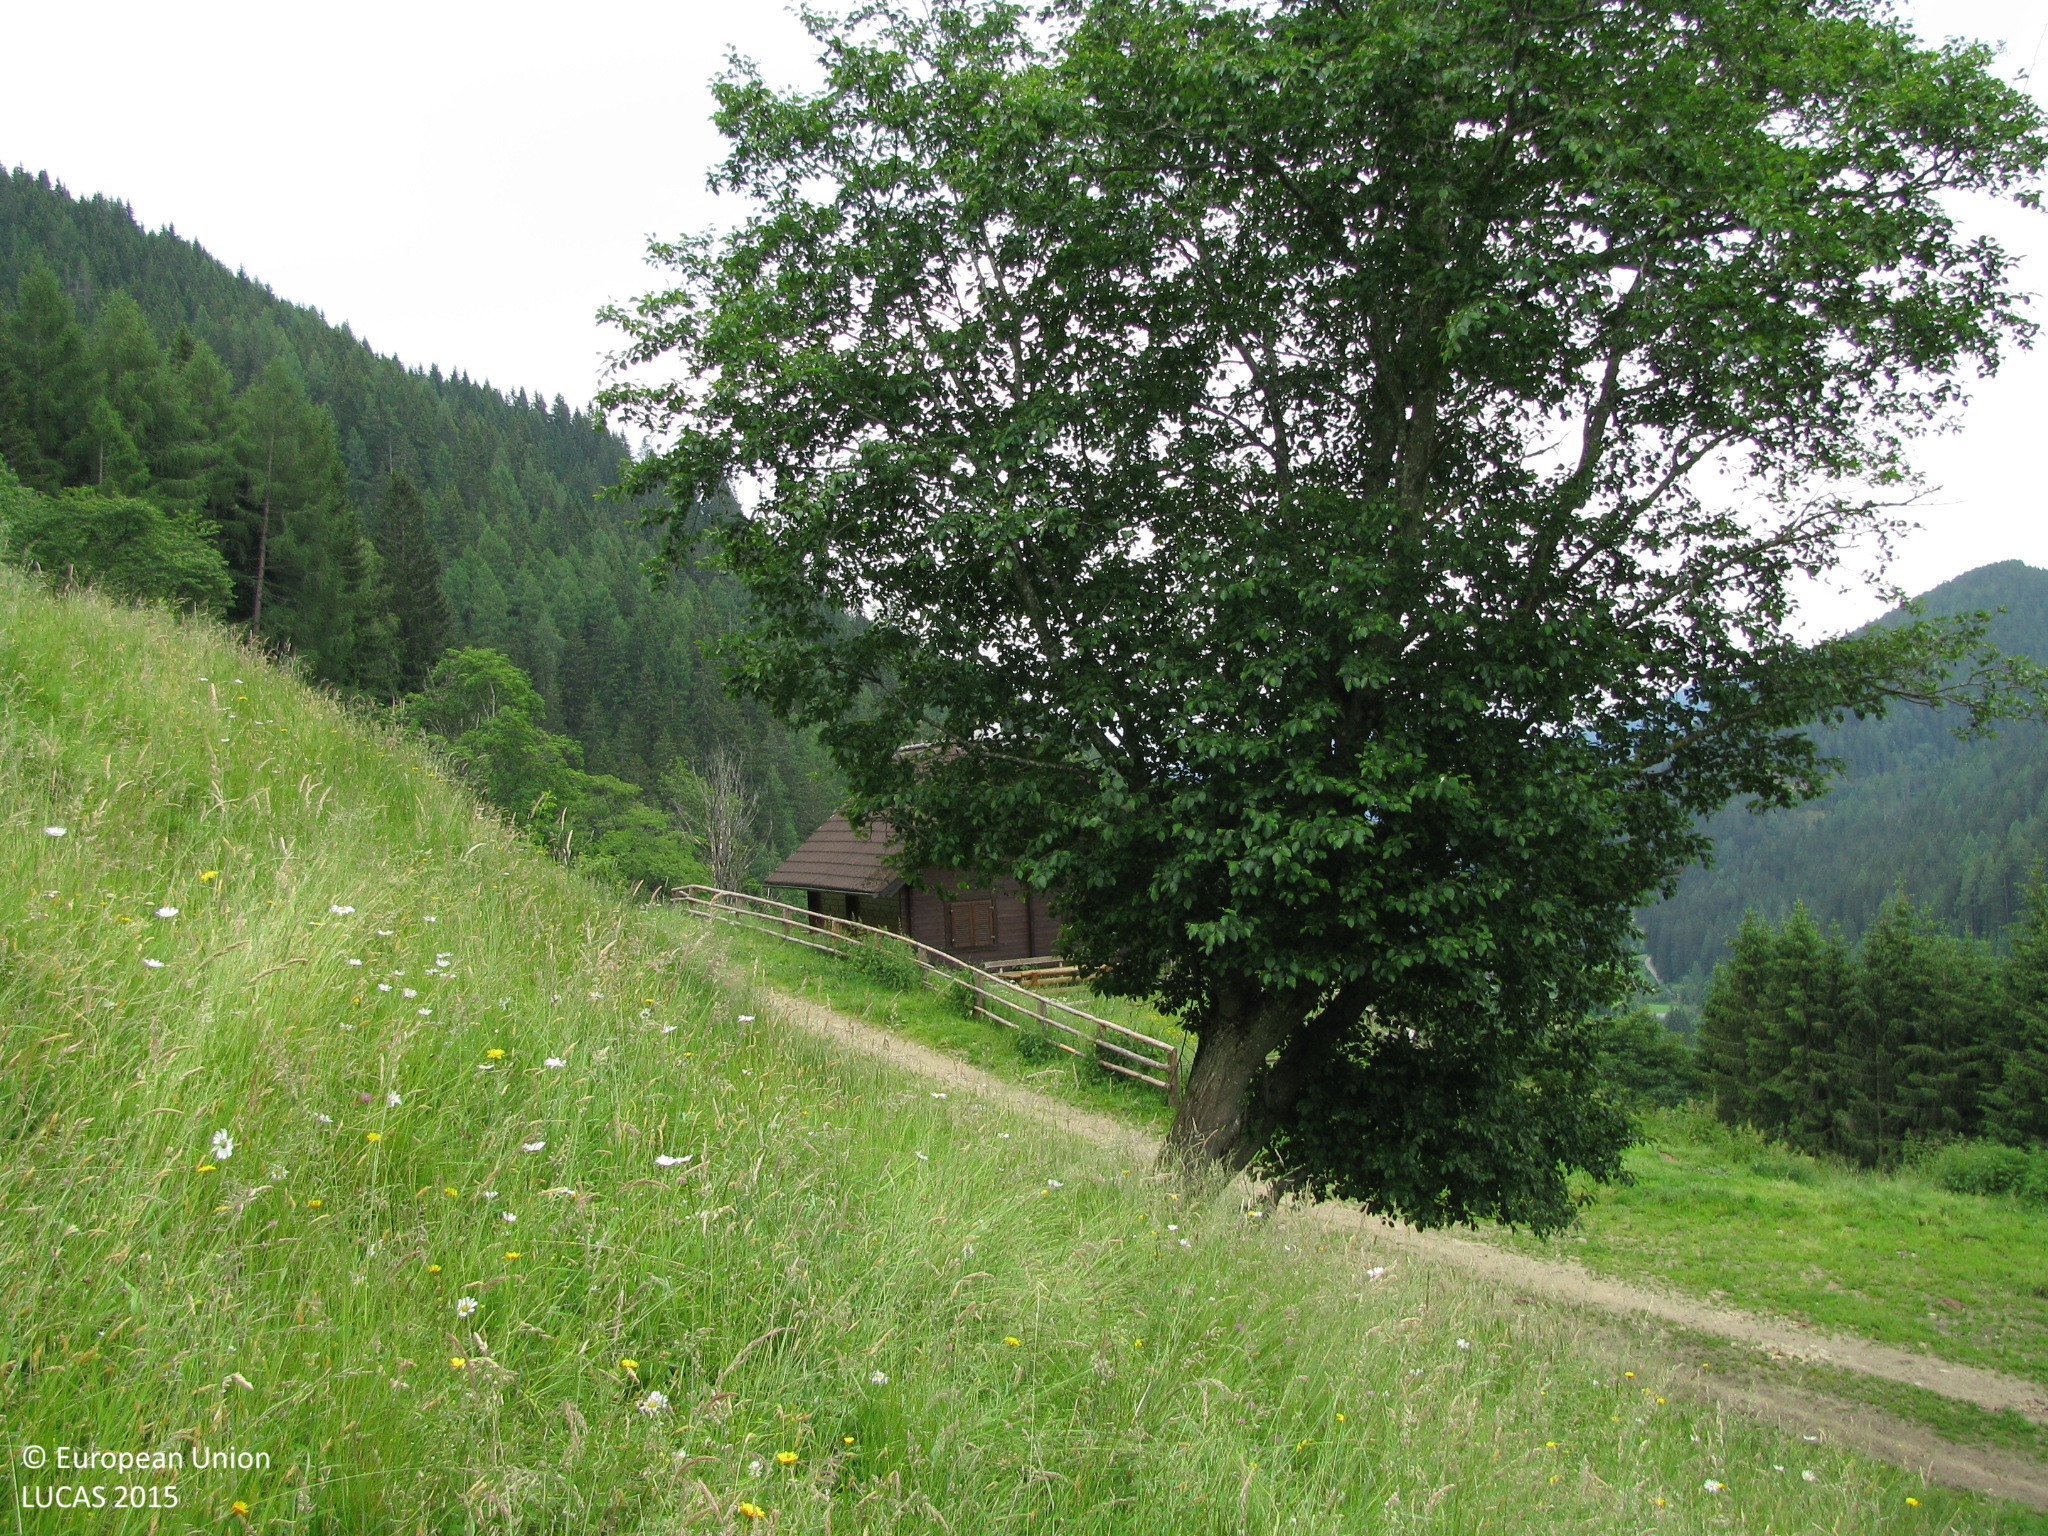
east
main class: Grassland
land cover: Grassland without tree/shrub cover
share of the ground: > 75 %
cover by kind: herbaceous plants 100 %
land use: Agriculture (excluding fallow land and kitchen gardens)
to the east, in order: Grassland without tree/shrub cover; Tracks; Grass margins; Artificial constructions in urban areas; Grassland with sparse tree/shrub cover; Fences; Spruce dominated mixed woodland
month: June
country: AT
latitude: 47.2786
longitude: 14.6391
